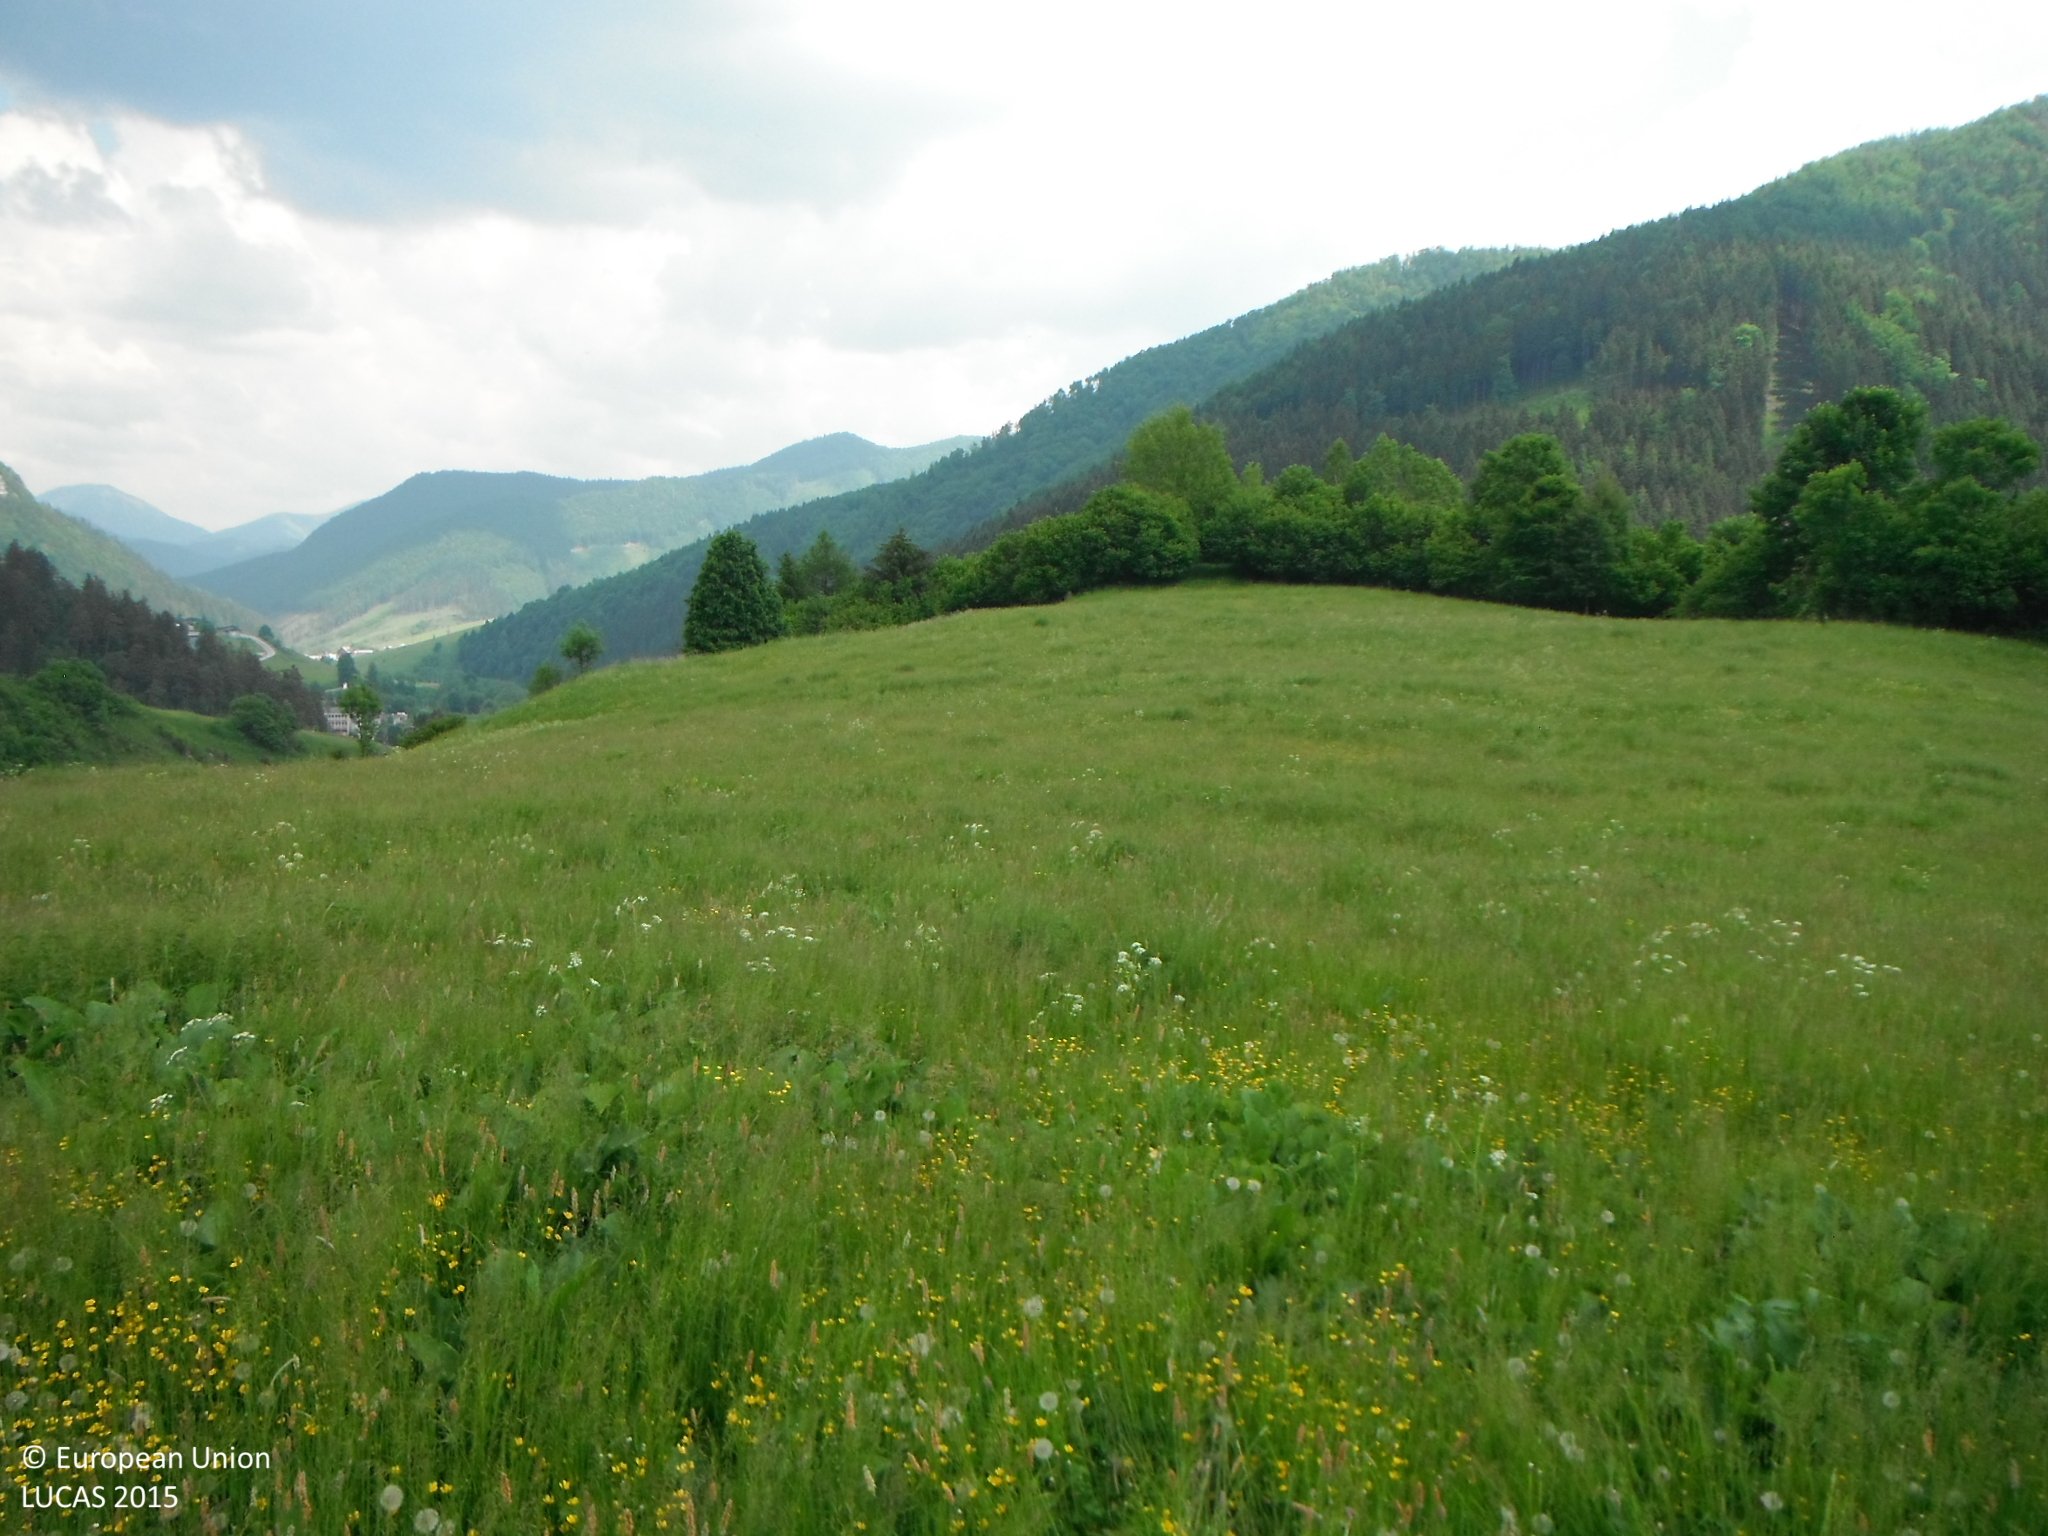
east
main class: Grassland
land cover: Grassland without tree/shrub cover
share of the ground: > 75 %
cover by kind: herbaceous plants 100 %
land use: Agriculture (excluding fallow land and kitchen gardens)
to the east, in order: Grassland without tree/shrub cover; Shrubland without tree cover; Grassland with sparse tree/shrub cover; Grassland without tree/shrub cover; Electric lines; Grassland without tree/shrub cover
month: June
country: SK
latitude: 48.9261
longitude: 19.1812
